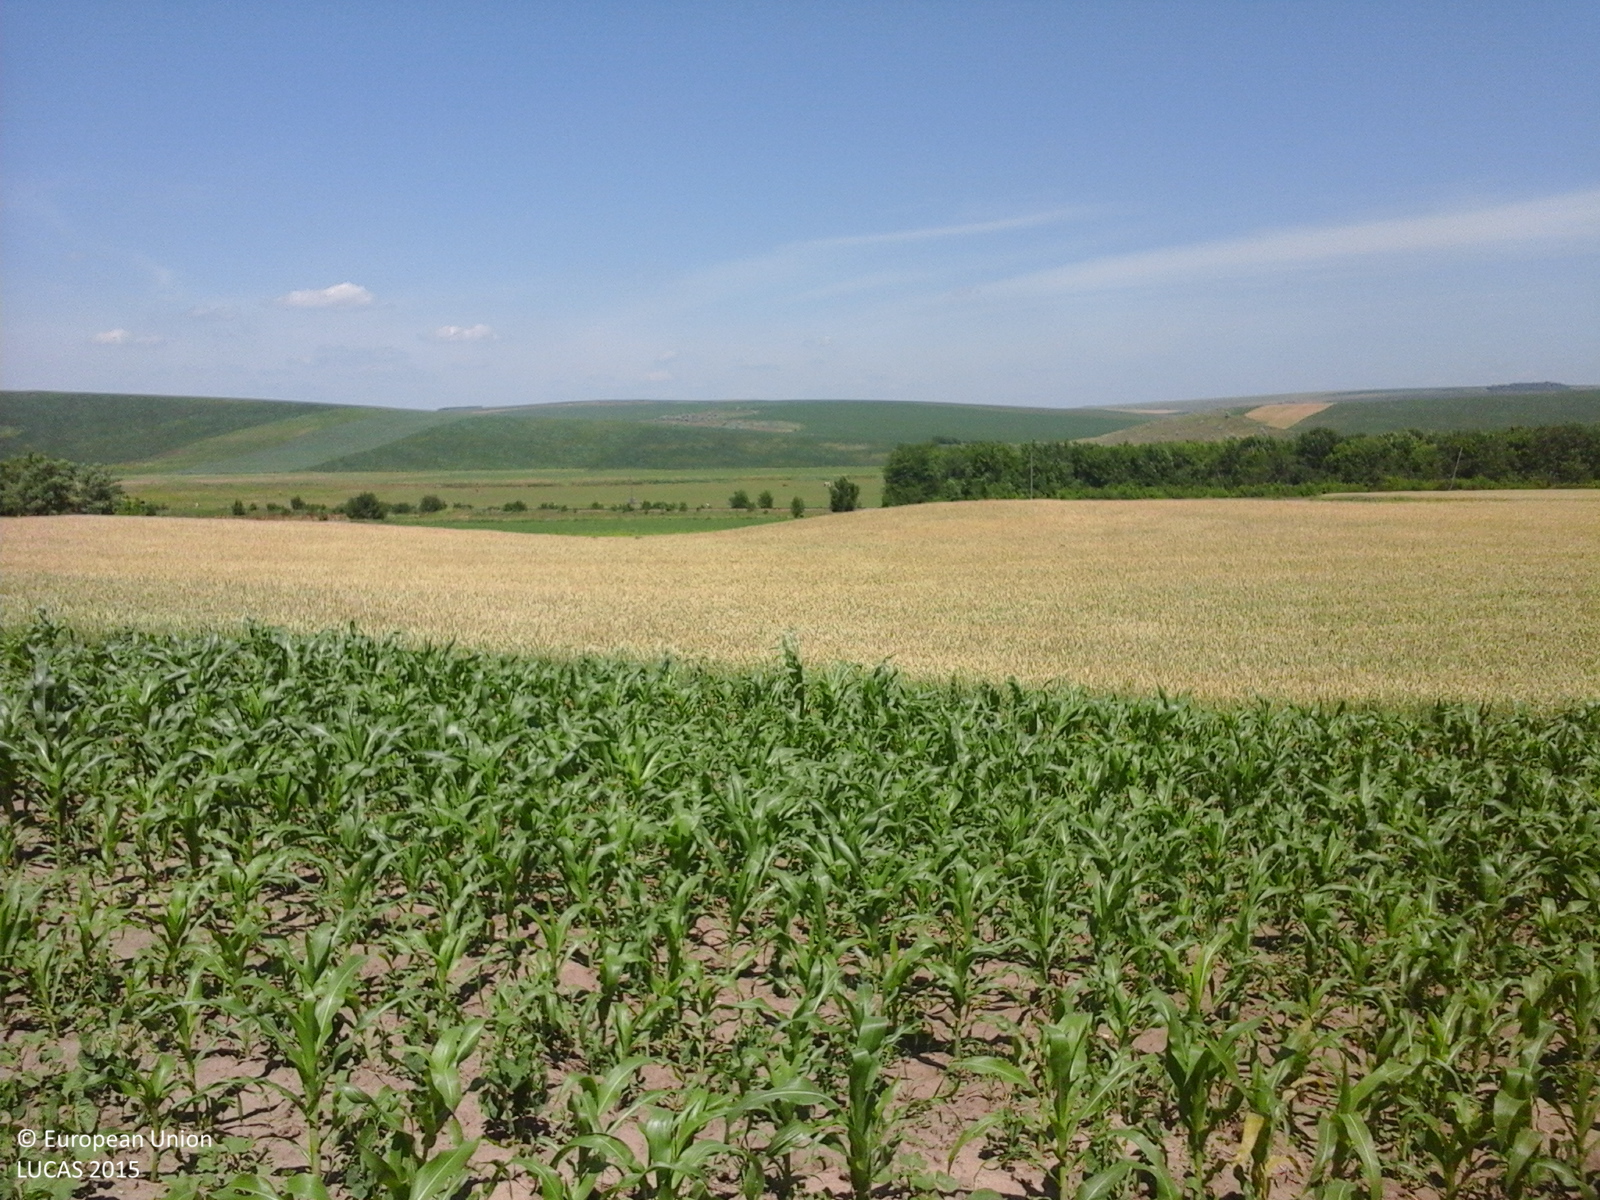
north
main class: Cropland
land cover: Maize
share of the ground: 25 - 50 %
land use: Agriculture (excluding fallow land and kitchen gardens)
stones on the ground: < 10 %
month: June
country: RO
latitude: 47.8653
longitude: 26.8788
